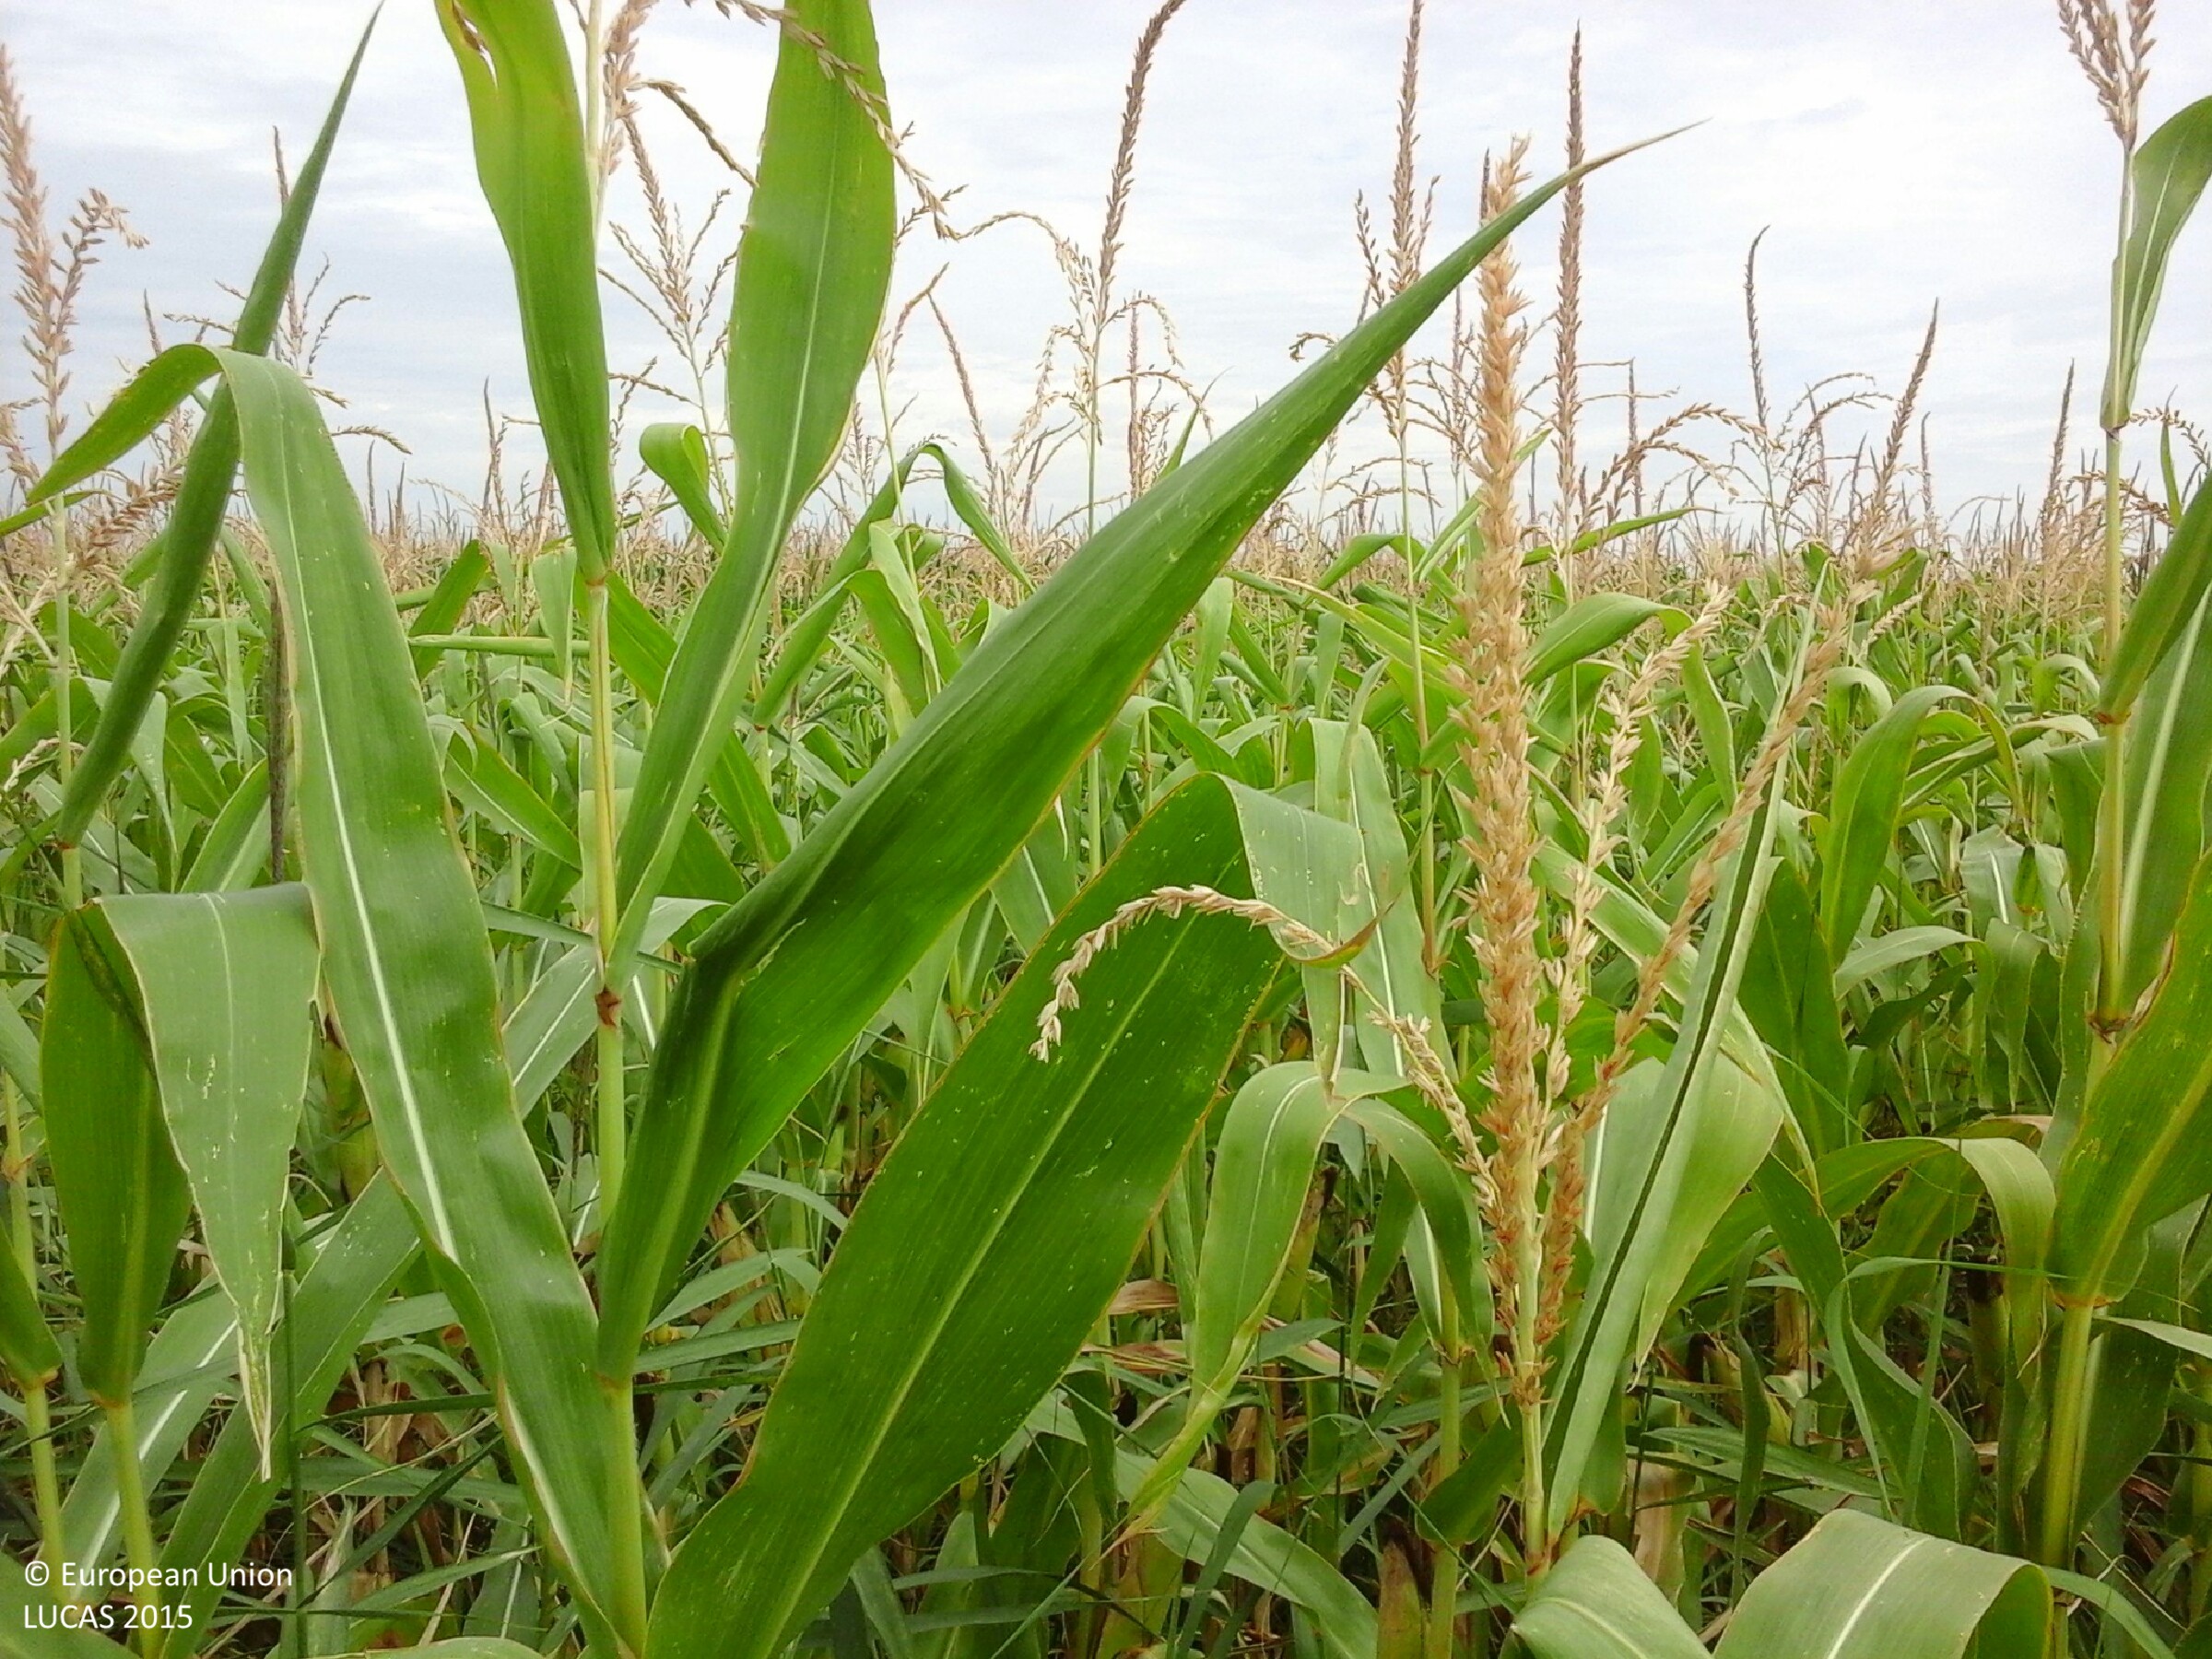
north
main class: Cropland
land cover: Maize
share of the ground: > 75 %
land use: Agriculture (excluding fallow land and kitchen gardens)
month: July
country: HU
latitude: 47.4055
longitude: 20.7538
